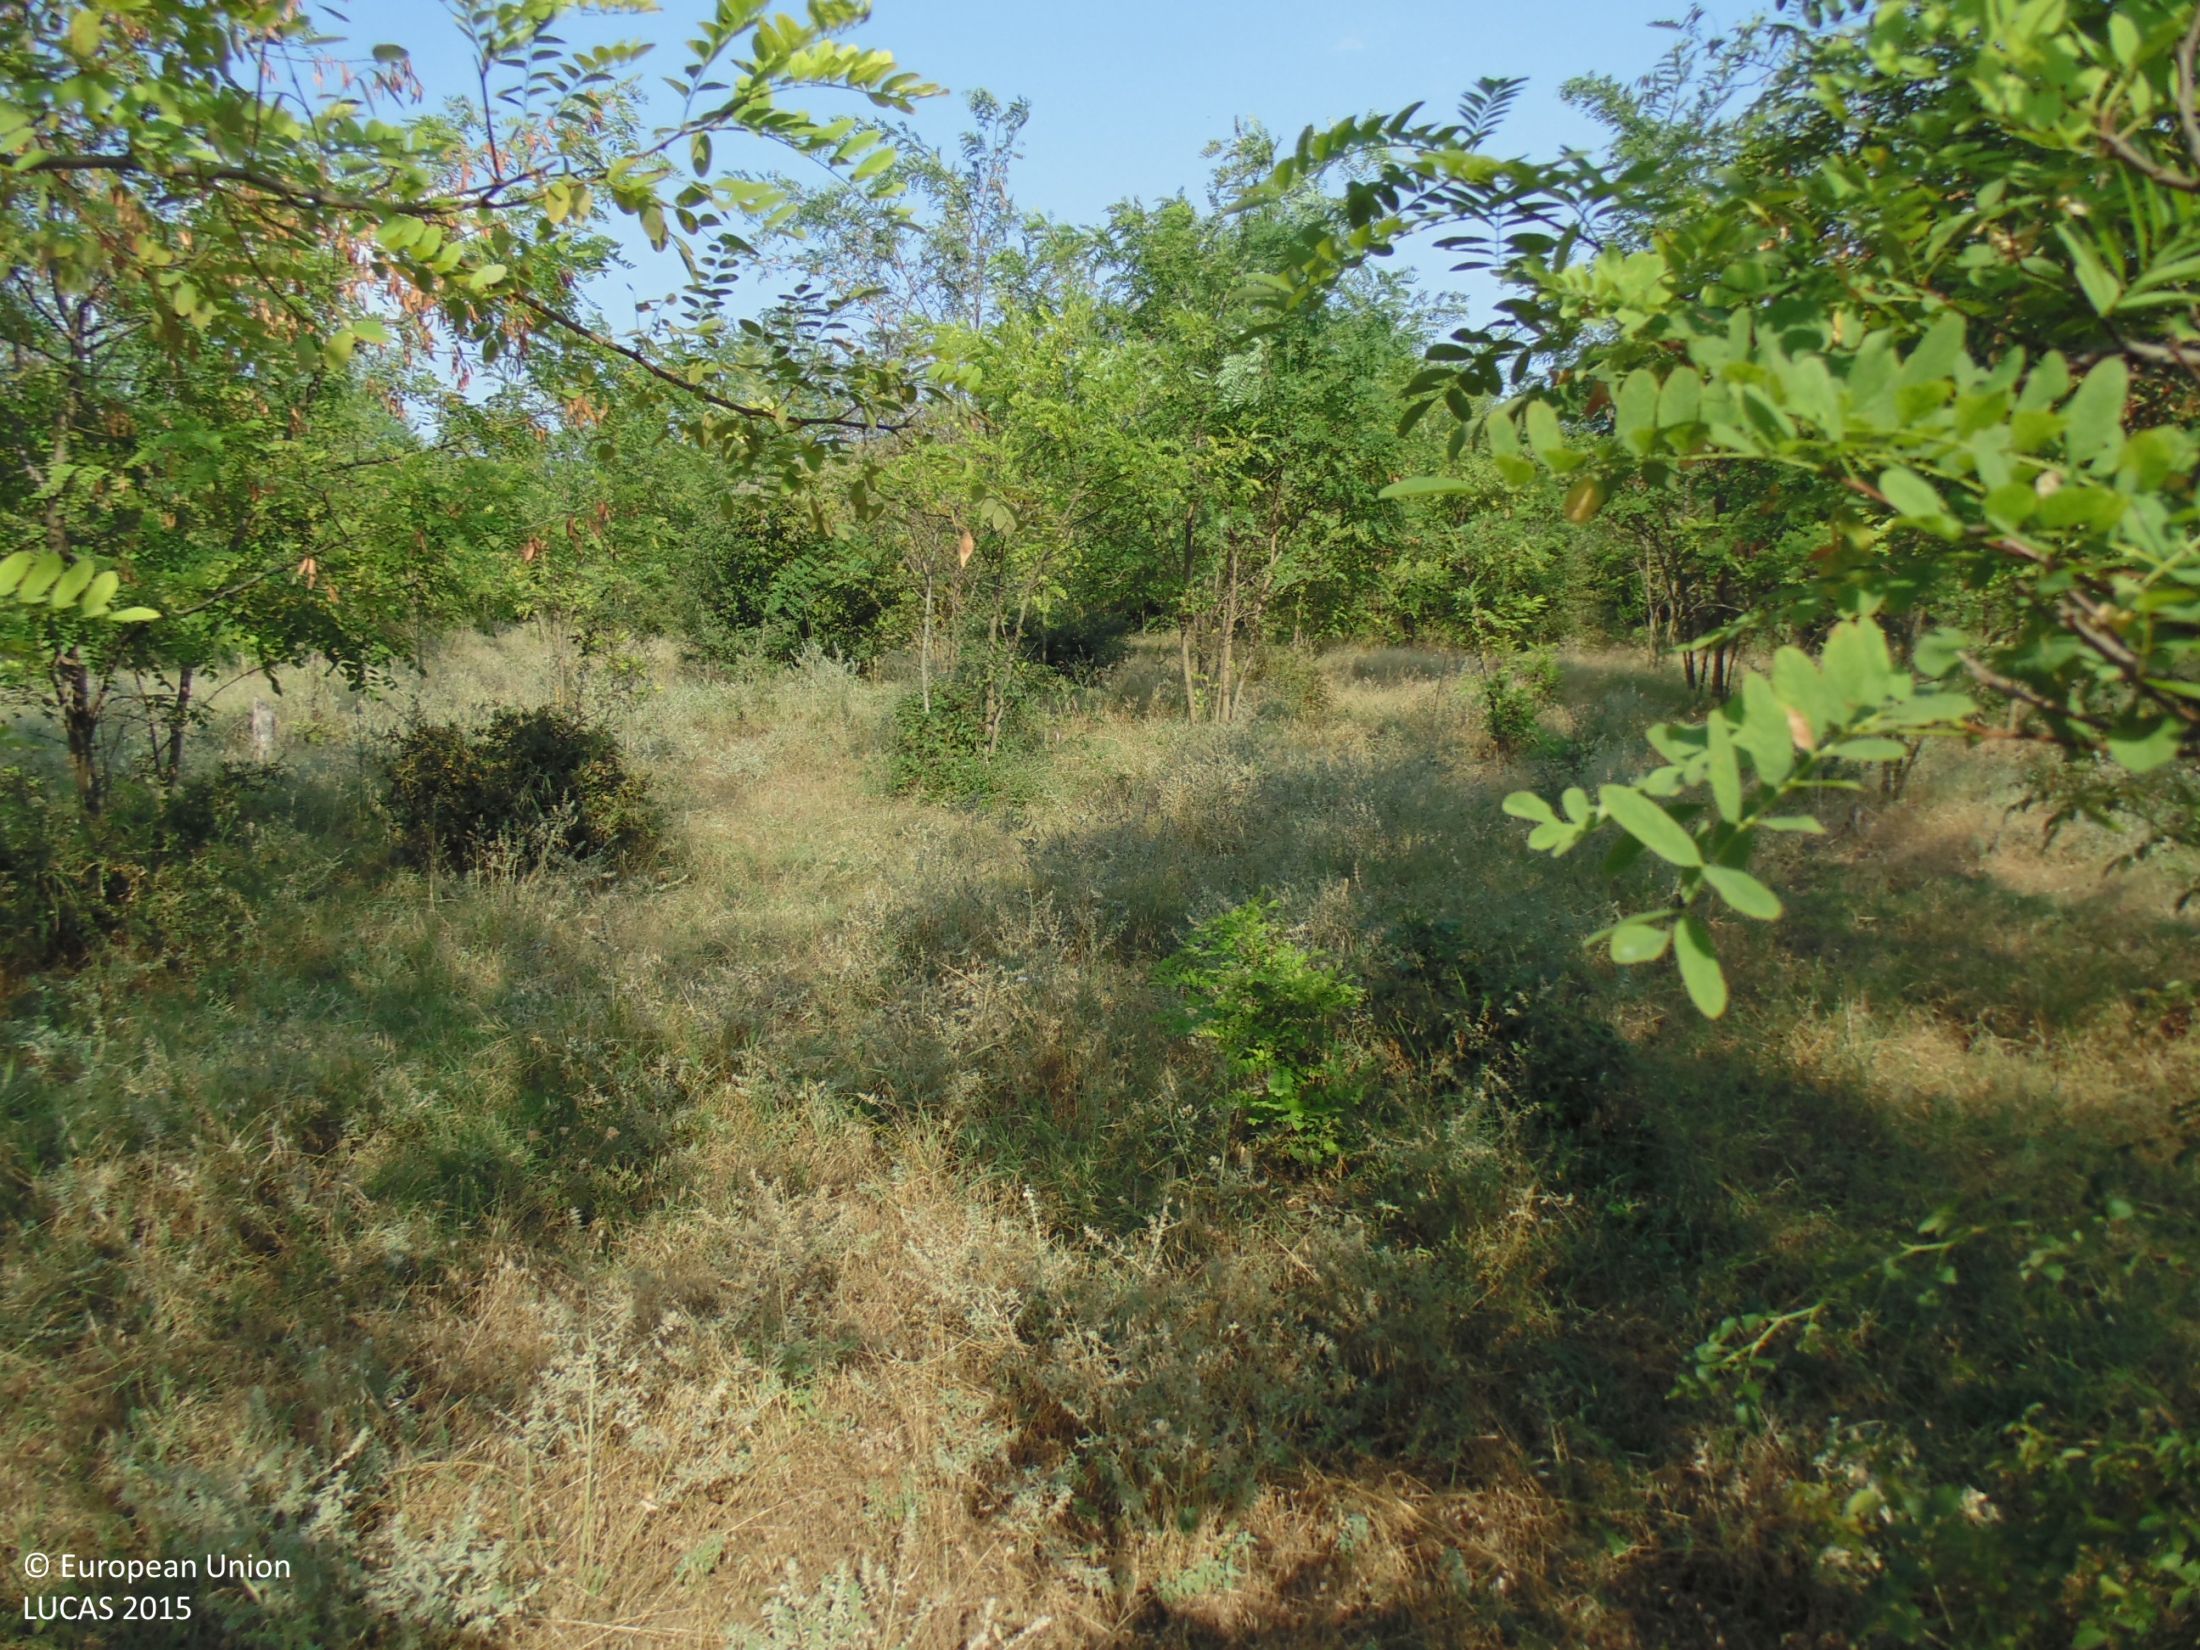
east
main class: Woodland
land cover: Broadleaved woodland
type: mesophytic deciduous forest
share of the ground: > 75 %
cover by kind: broadleaved forest trees 90 %, shrubs 5 %, unconsolidated bare surface 5 %
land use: Forestry
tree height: > 5 m
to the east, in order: Broadleaved woodland
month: August
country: BG
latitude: 43.9512
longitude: 27.5197
